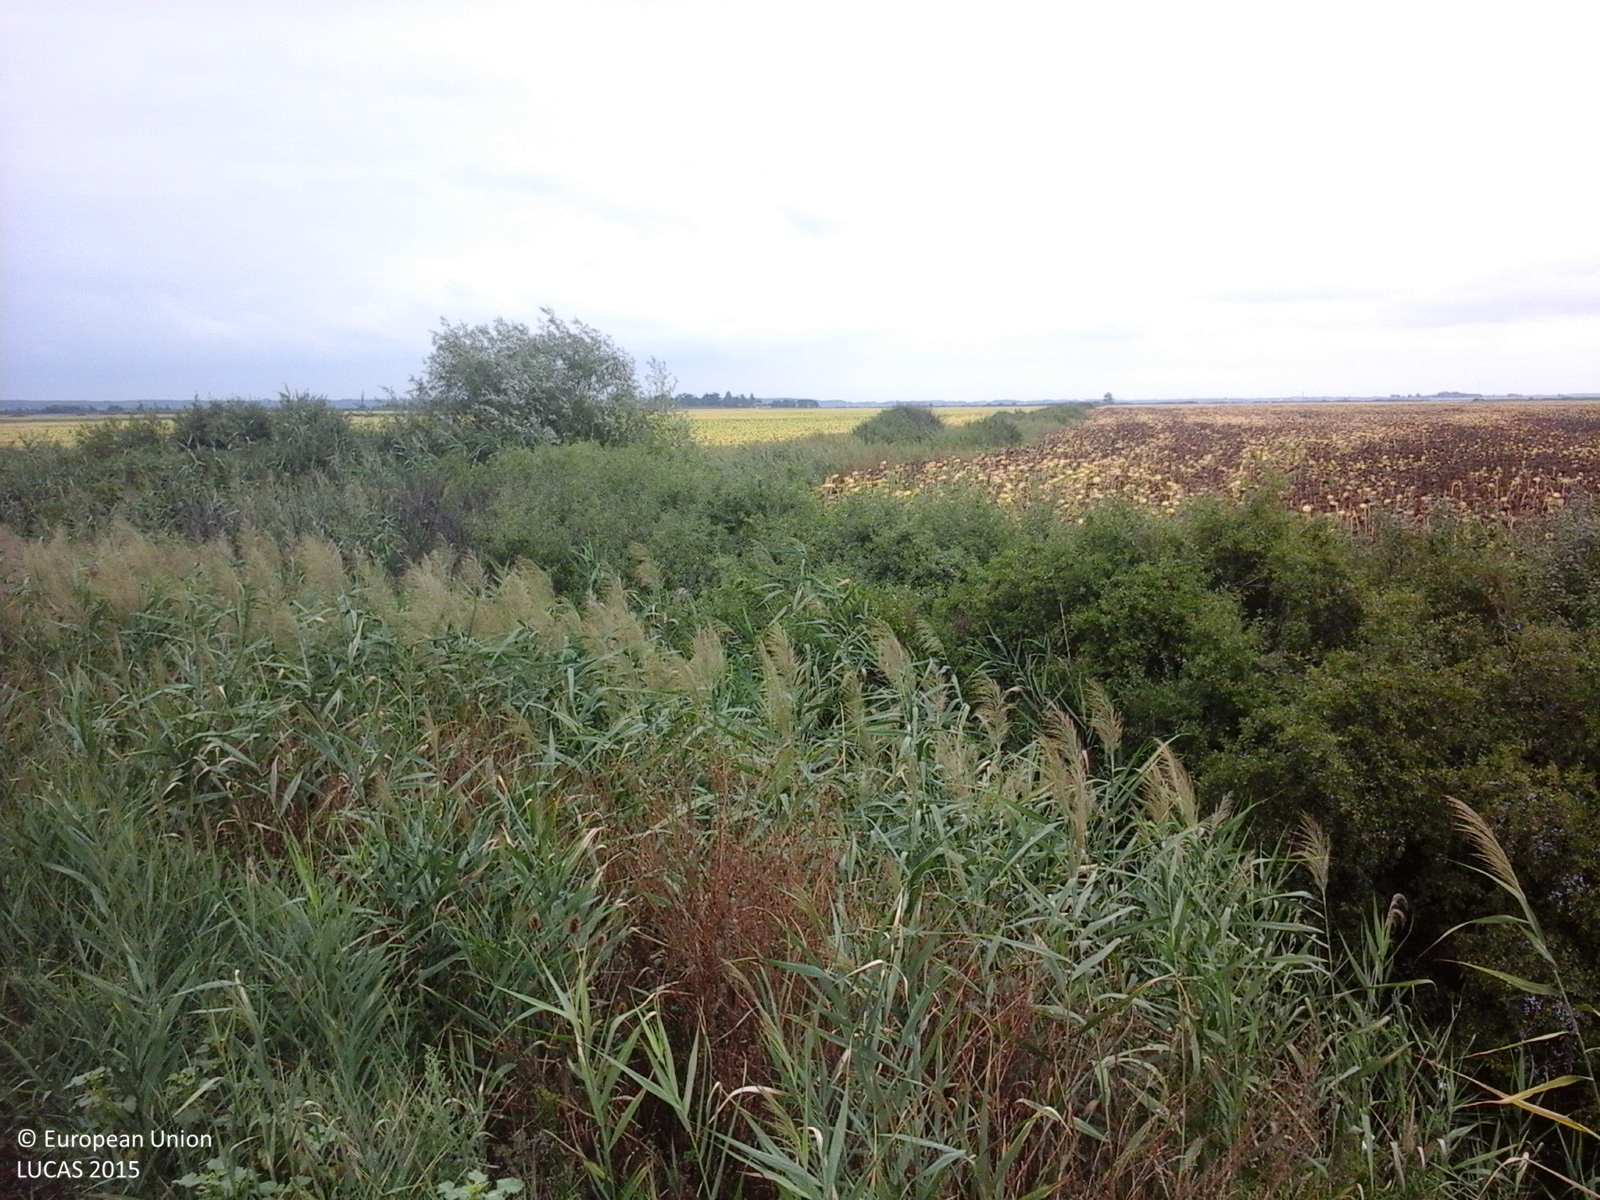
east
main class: Cropland
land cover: Sunflower
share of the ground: > 75 %
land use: Agriculture (excluding fallow land and kitchen gardens)
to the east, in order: Sunflower; Grass margins; Ditches and canals; Grass margins; Sunflower
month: August
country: RO
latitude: 46.1241
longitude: 20.4942
